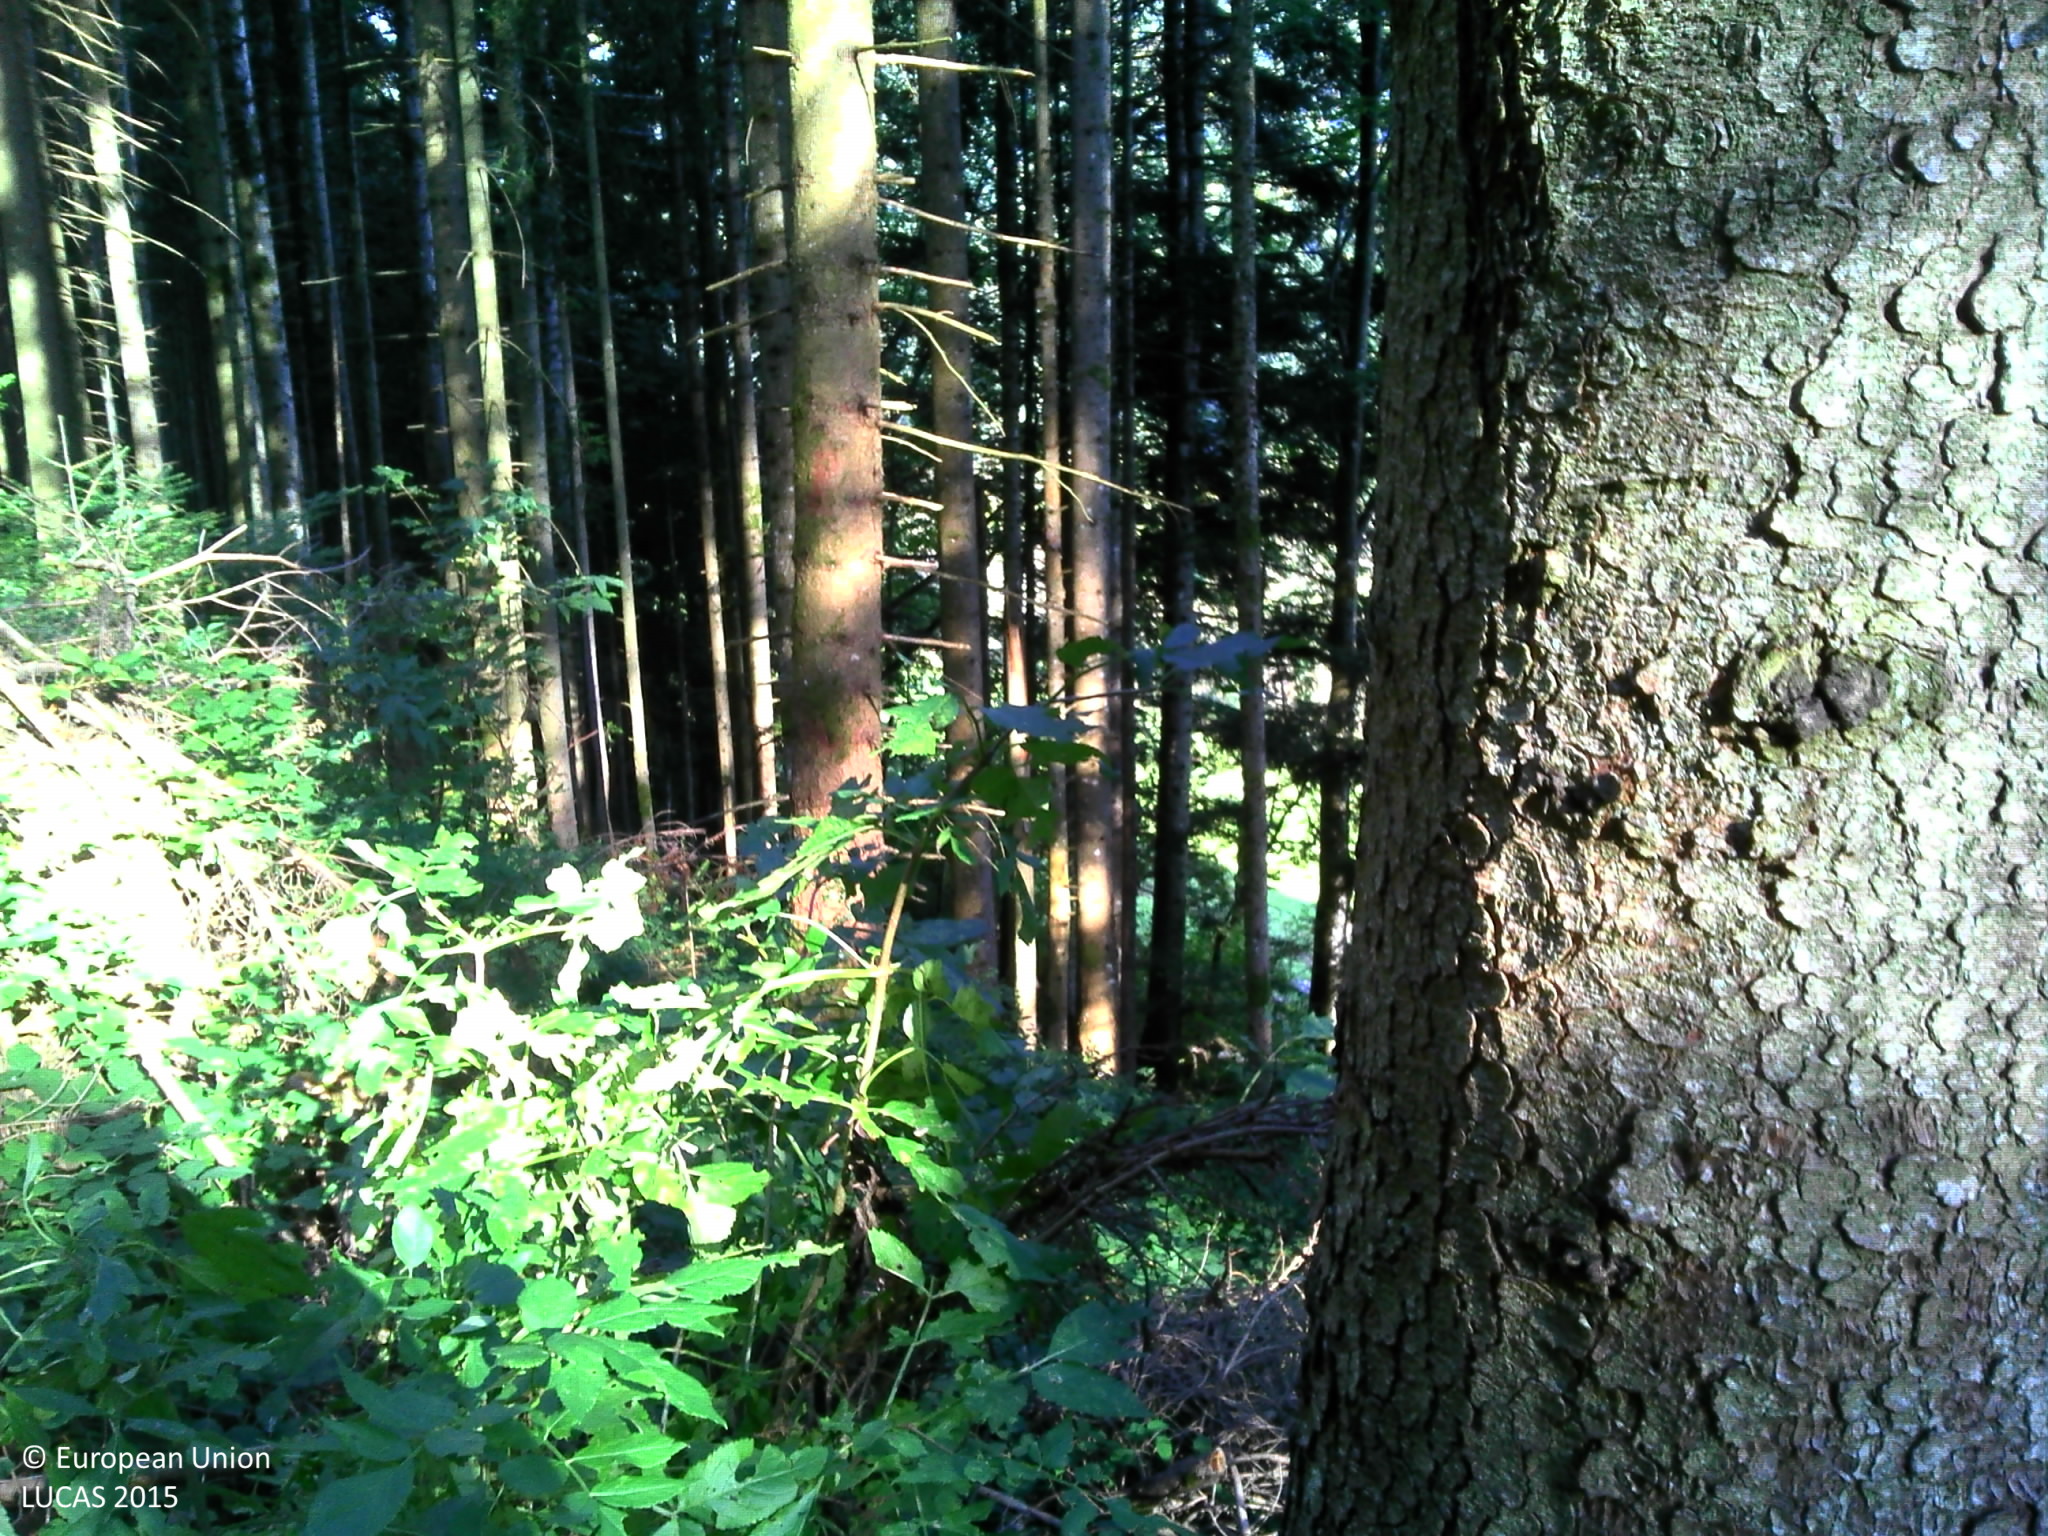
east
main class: Woodland
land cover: Spruce dominated coniferous woodland
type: exotic forest
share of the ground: > 75 %
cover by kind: coniferous forest trees 90 %, herbaceous plants 10 %
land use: Forestry
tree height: > 5 m
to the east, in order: Spruce dominated coniferous woodland; Fences; Tracks; Grassland without tree/shrub cover; Electric lines; Fences; Grass margins; Paved roads, cycling and walking lanes; Grass margins; Fences; Broadleaved woodland
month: October
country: FR
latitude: 46.9213
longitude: 6.3911
